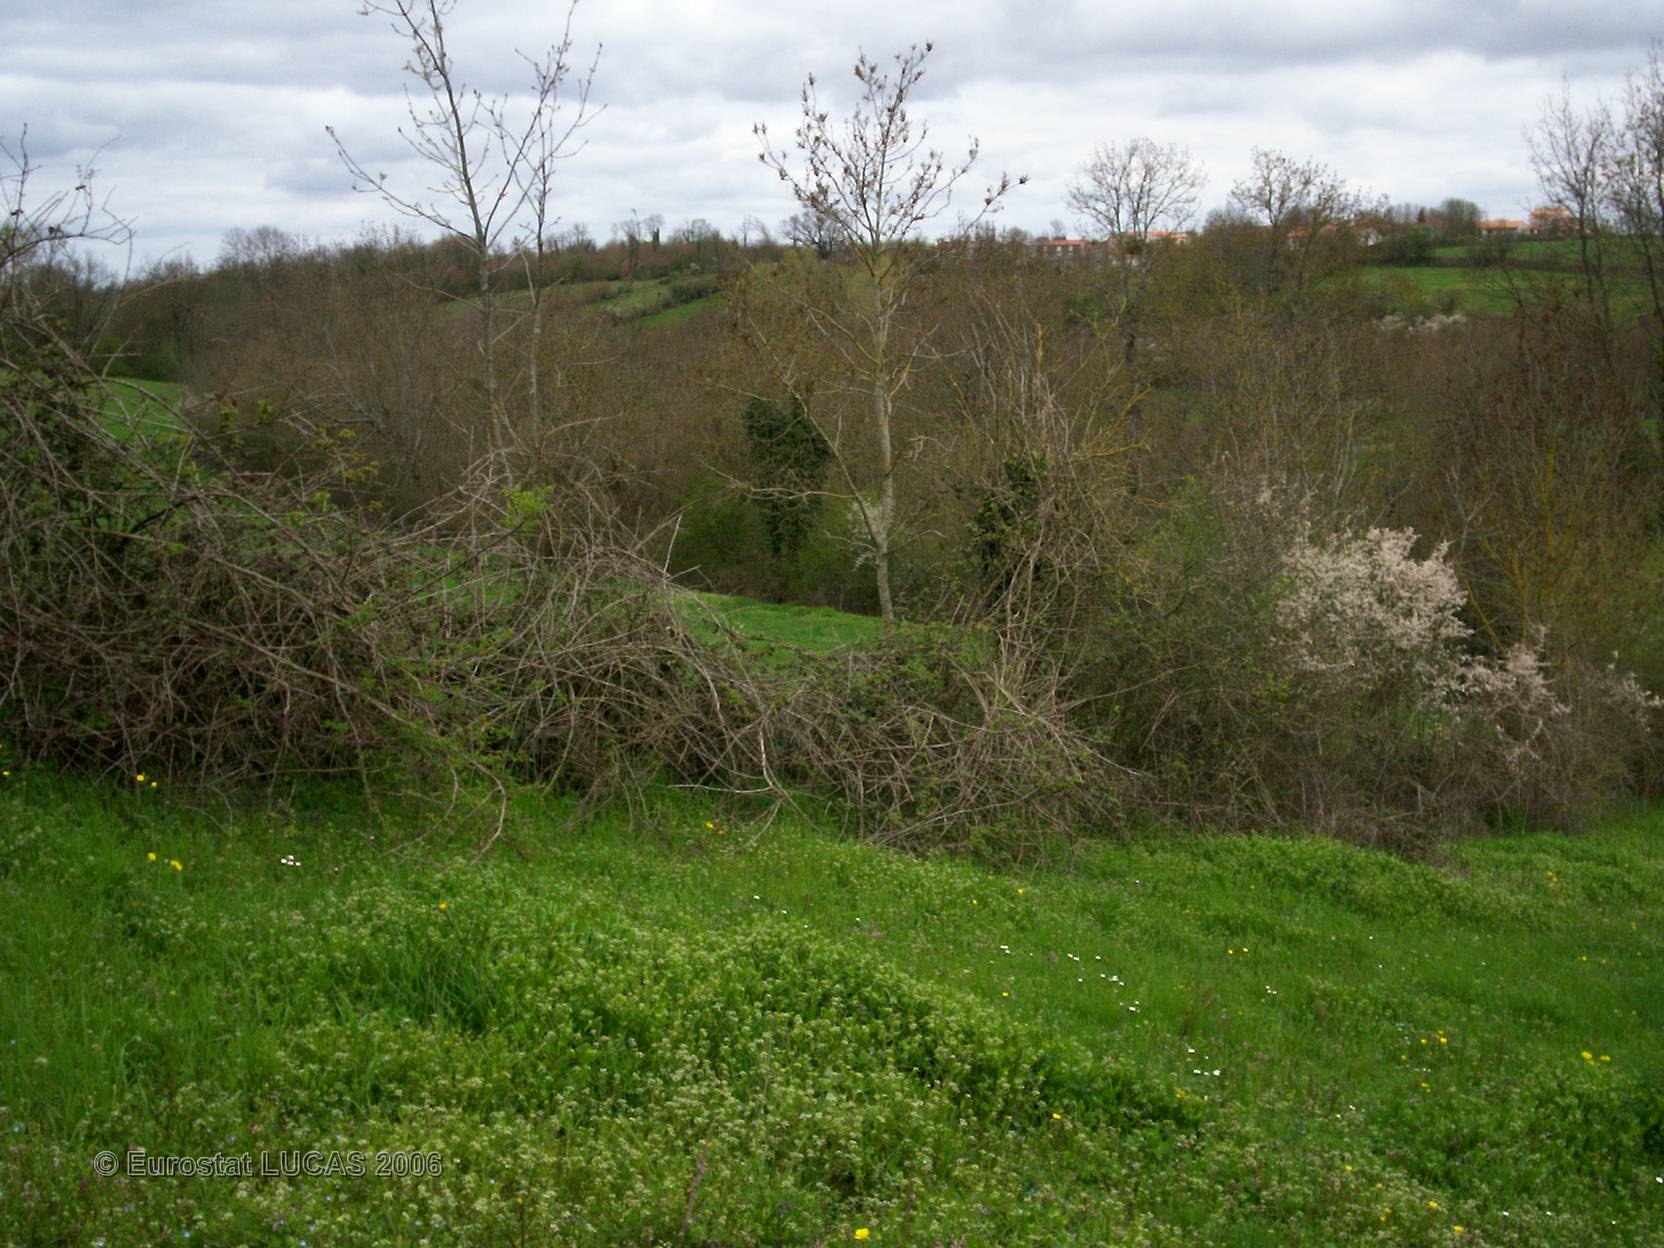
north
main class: Grassland
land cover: Grassland without tree/shrub cover
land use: Agriculture (excluding fallow land and kitchen gardens)
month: April
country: FR
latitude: 46.3095
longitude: -0.2685
